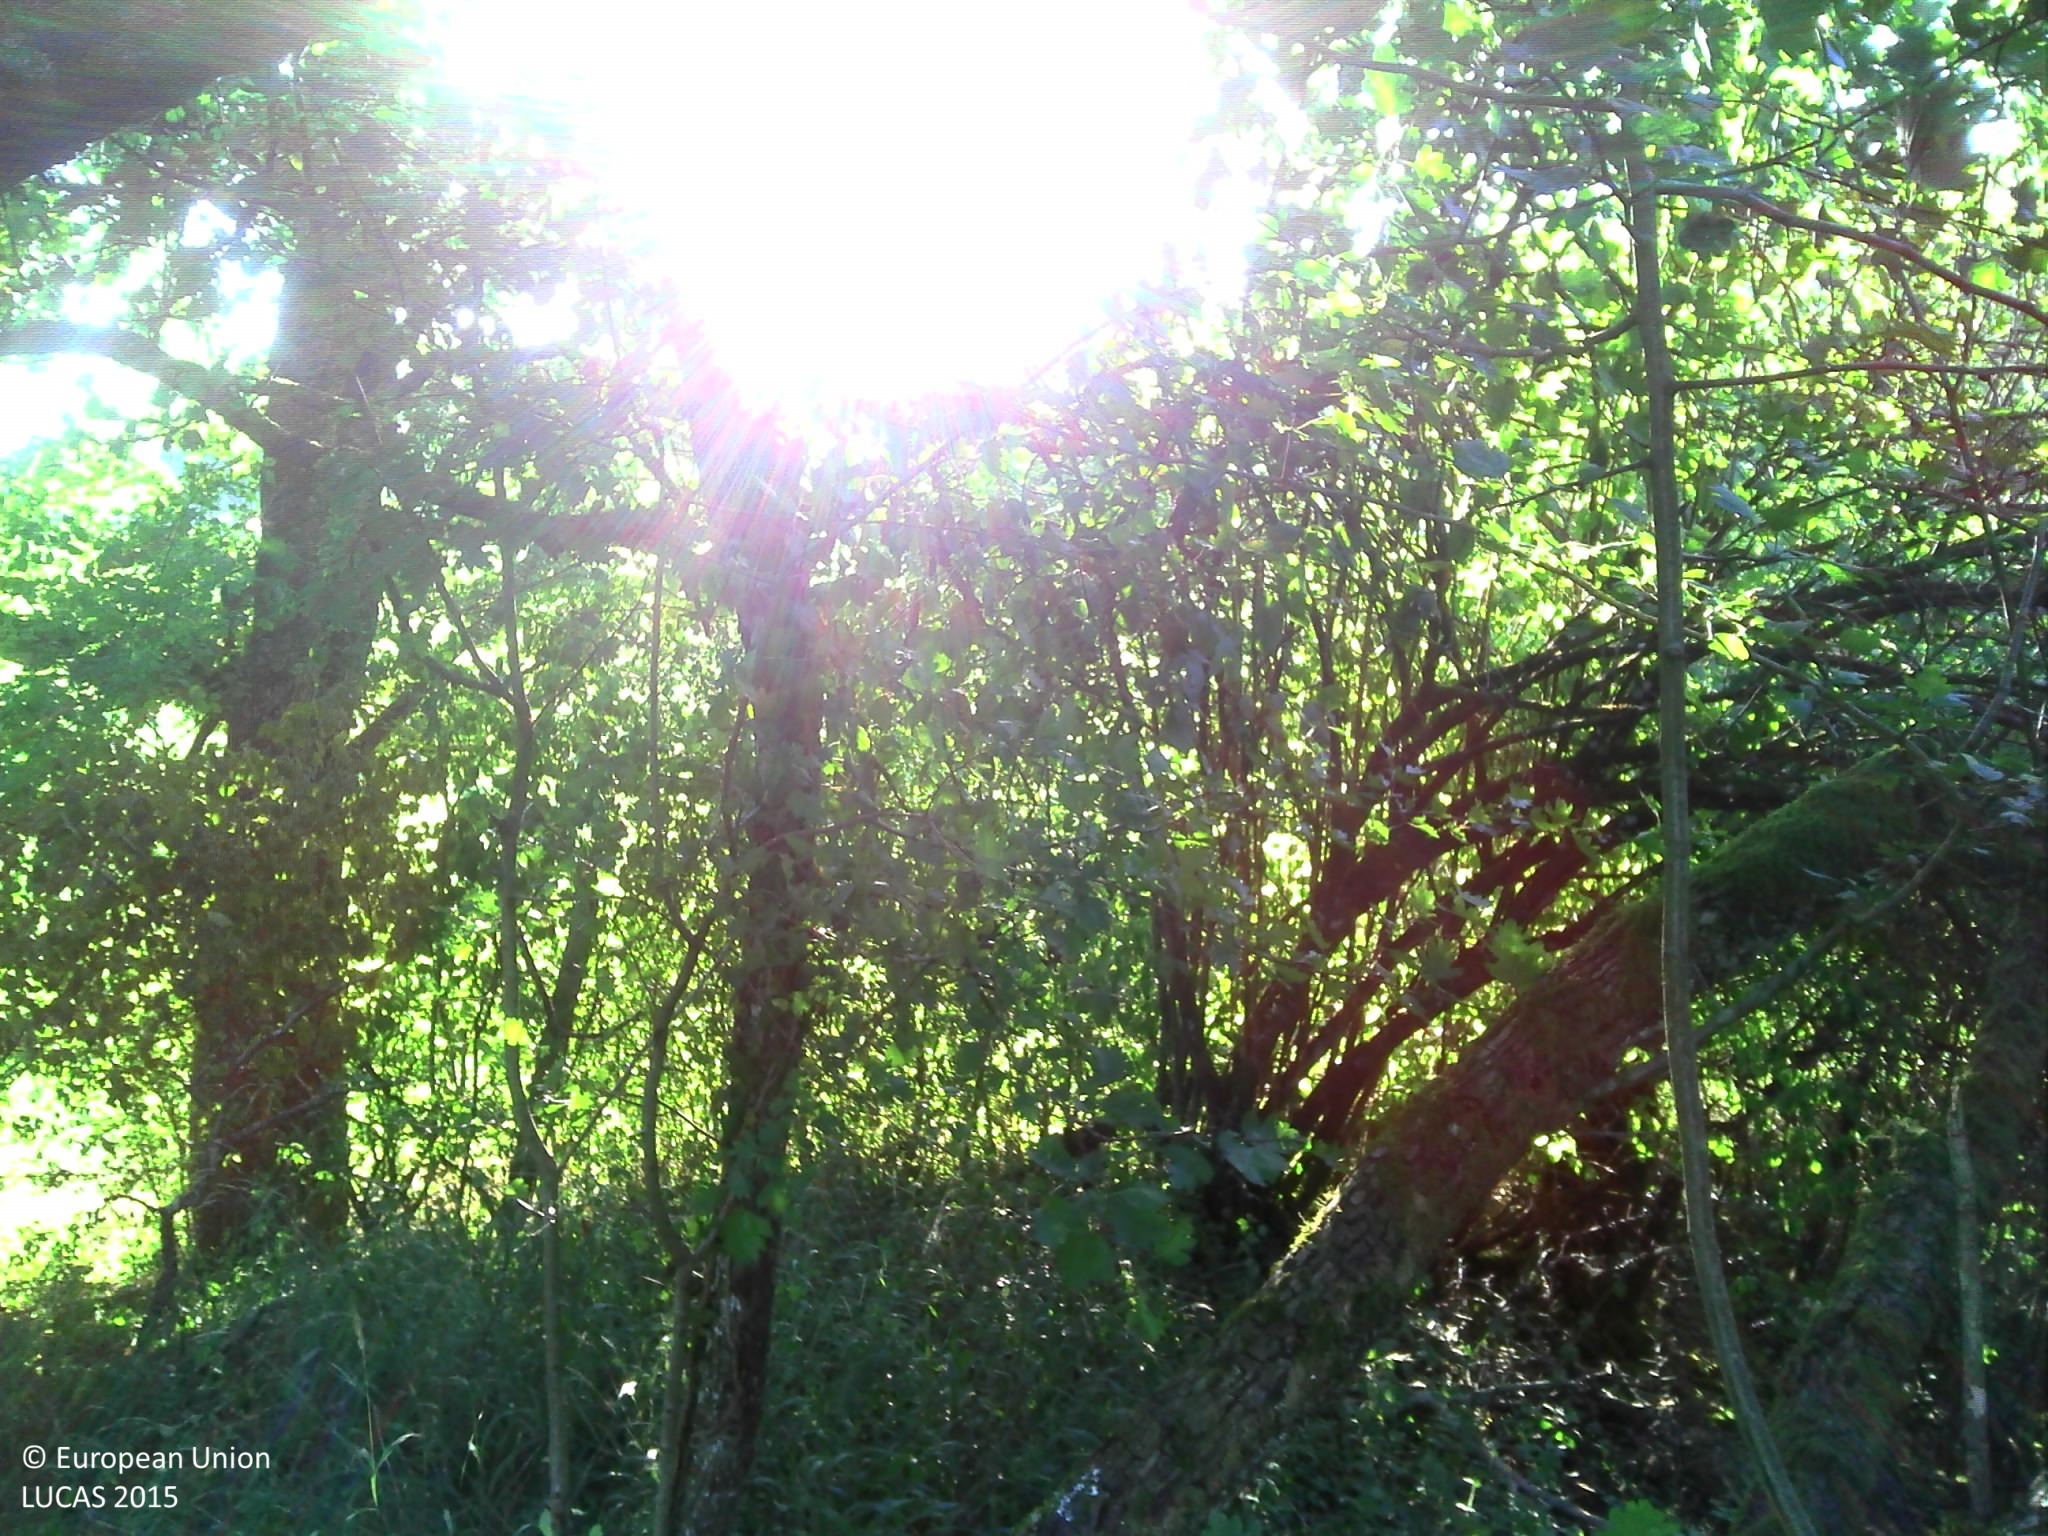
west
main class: Woodland
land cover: Broadleaved woodland
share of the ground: > 75 %
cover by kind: broadleaved forest trees 80 %, herbaceous plants 20 %
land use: Agriculture (excluding fallow land and kitchen gardens)
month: September
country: FR
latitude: 47.3150
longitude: 6.3109
